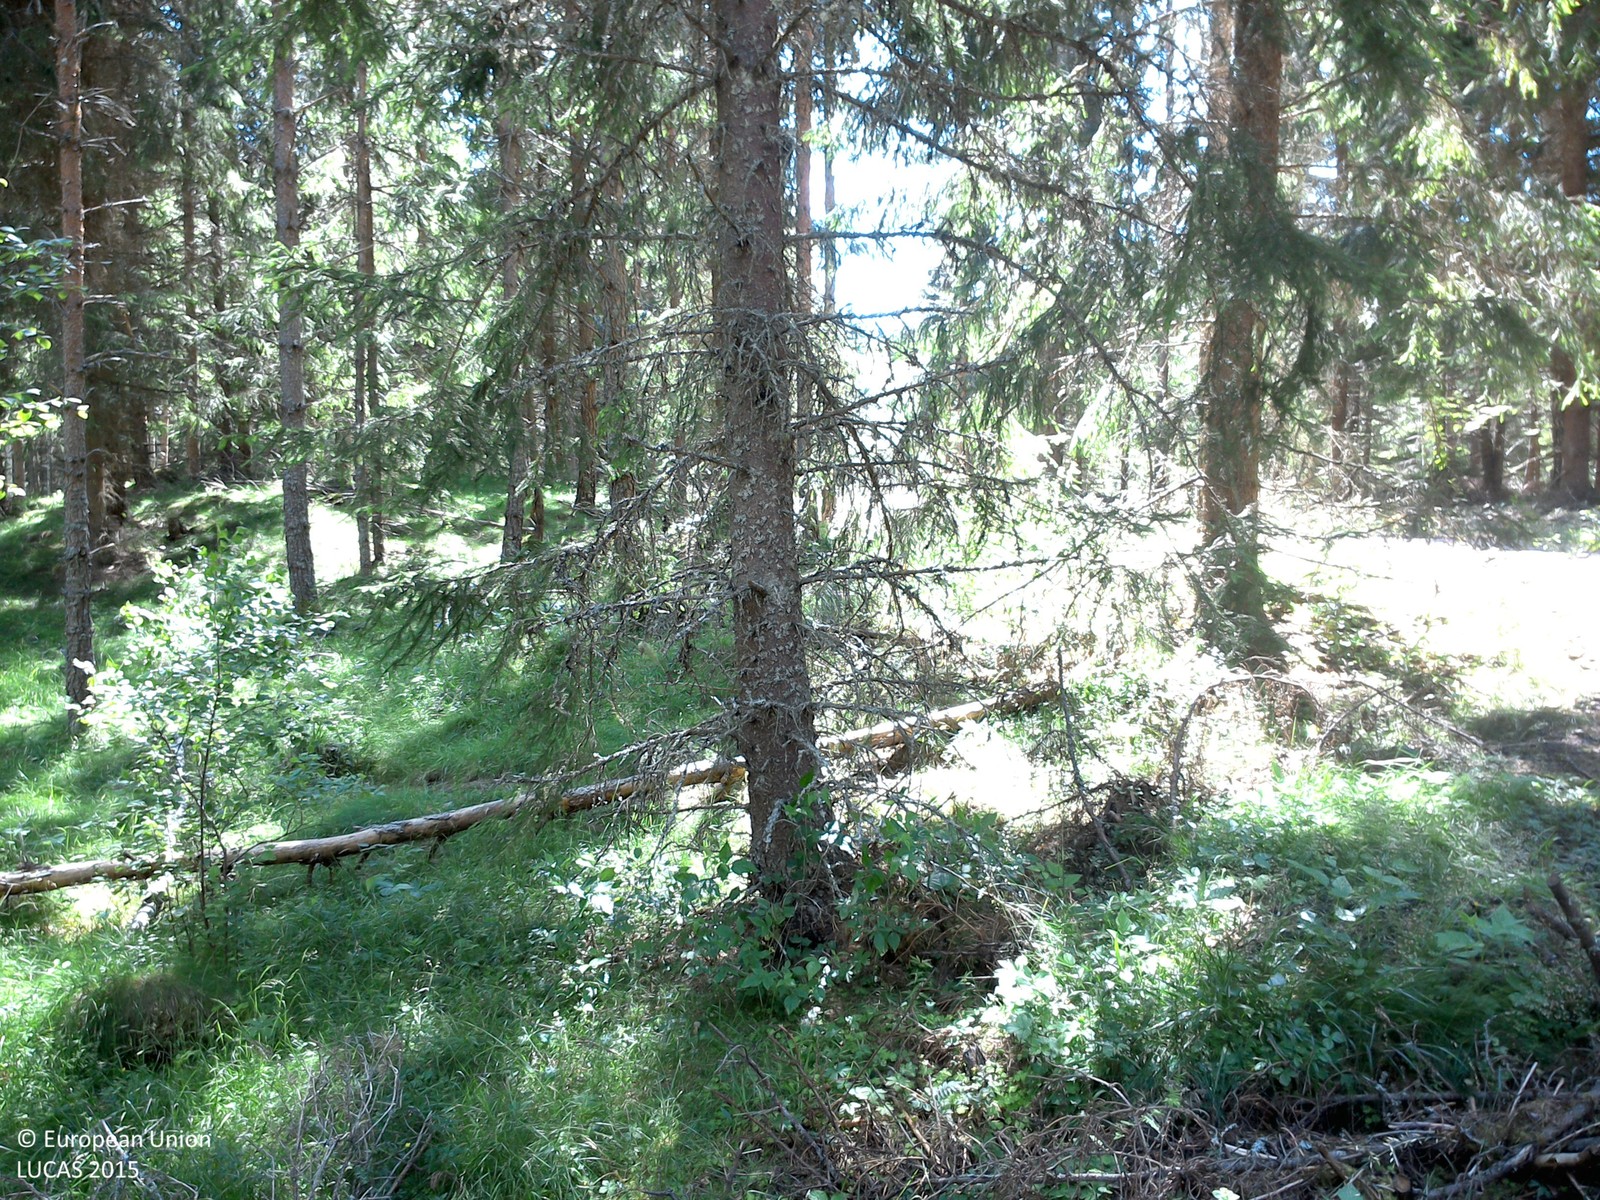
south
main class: Woodland
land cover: Pine dominated coniferous woodland
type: boreal forest
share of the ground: 50 - 75 %
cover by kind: coniferous forest trees 60 %, herbaceous plants 40 %
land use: Forestry
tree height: > 5 m
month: July
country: SE
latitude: 57.8920
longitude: 15.0051
